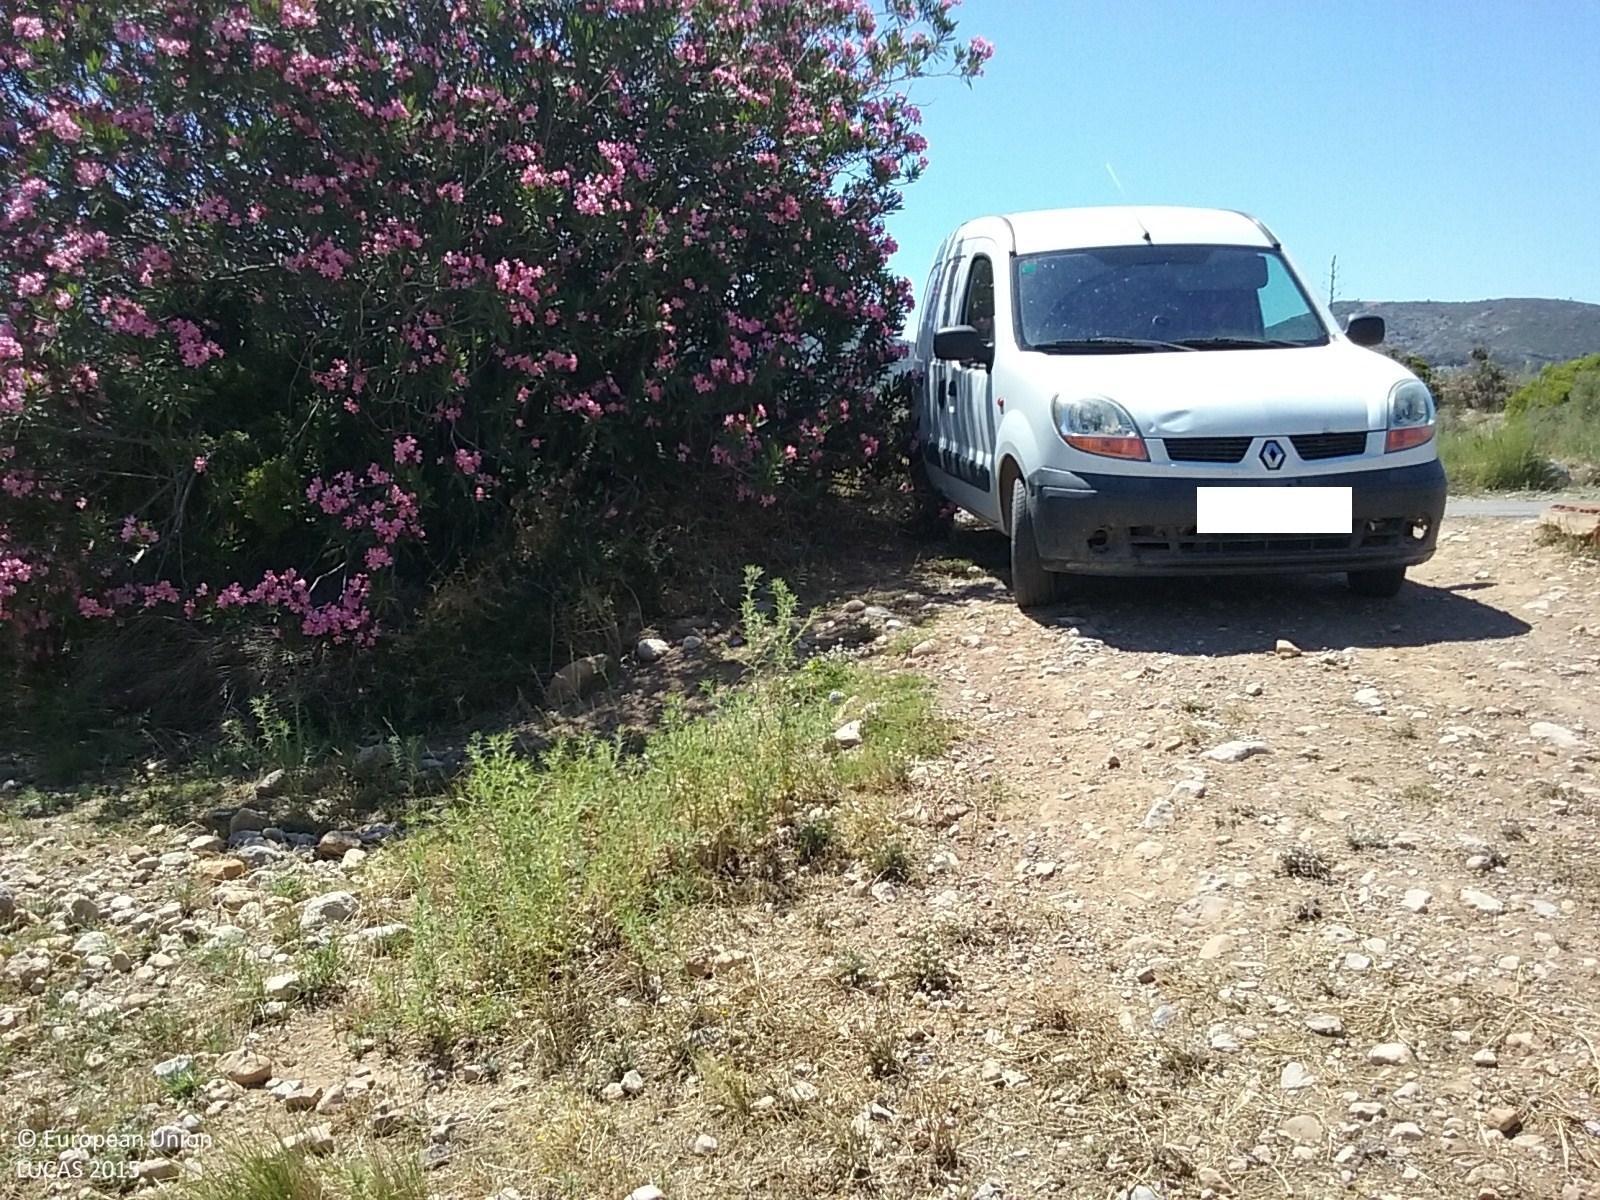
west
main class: Cropland
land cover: Other citrus fruit
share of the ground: < 10 %
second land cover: Grassland without tree/shrub cover
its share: 25 - 50 %
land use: Abandoned areas
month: June
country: ES
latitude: 40.1326
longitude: 0.1283
